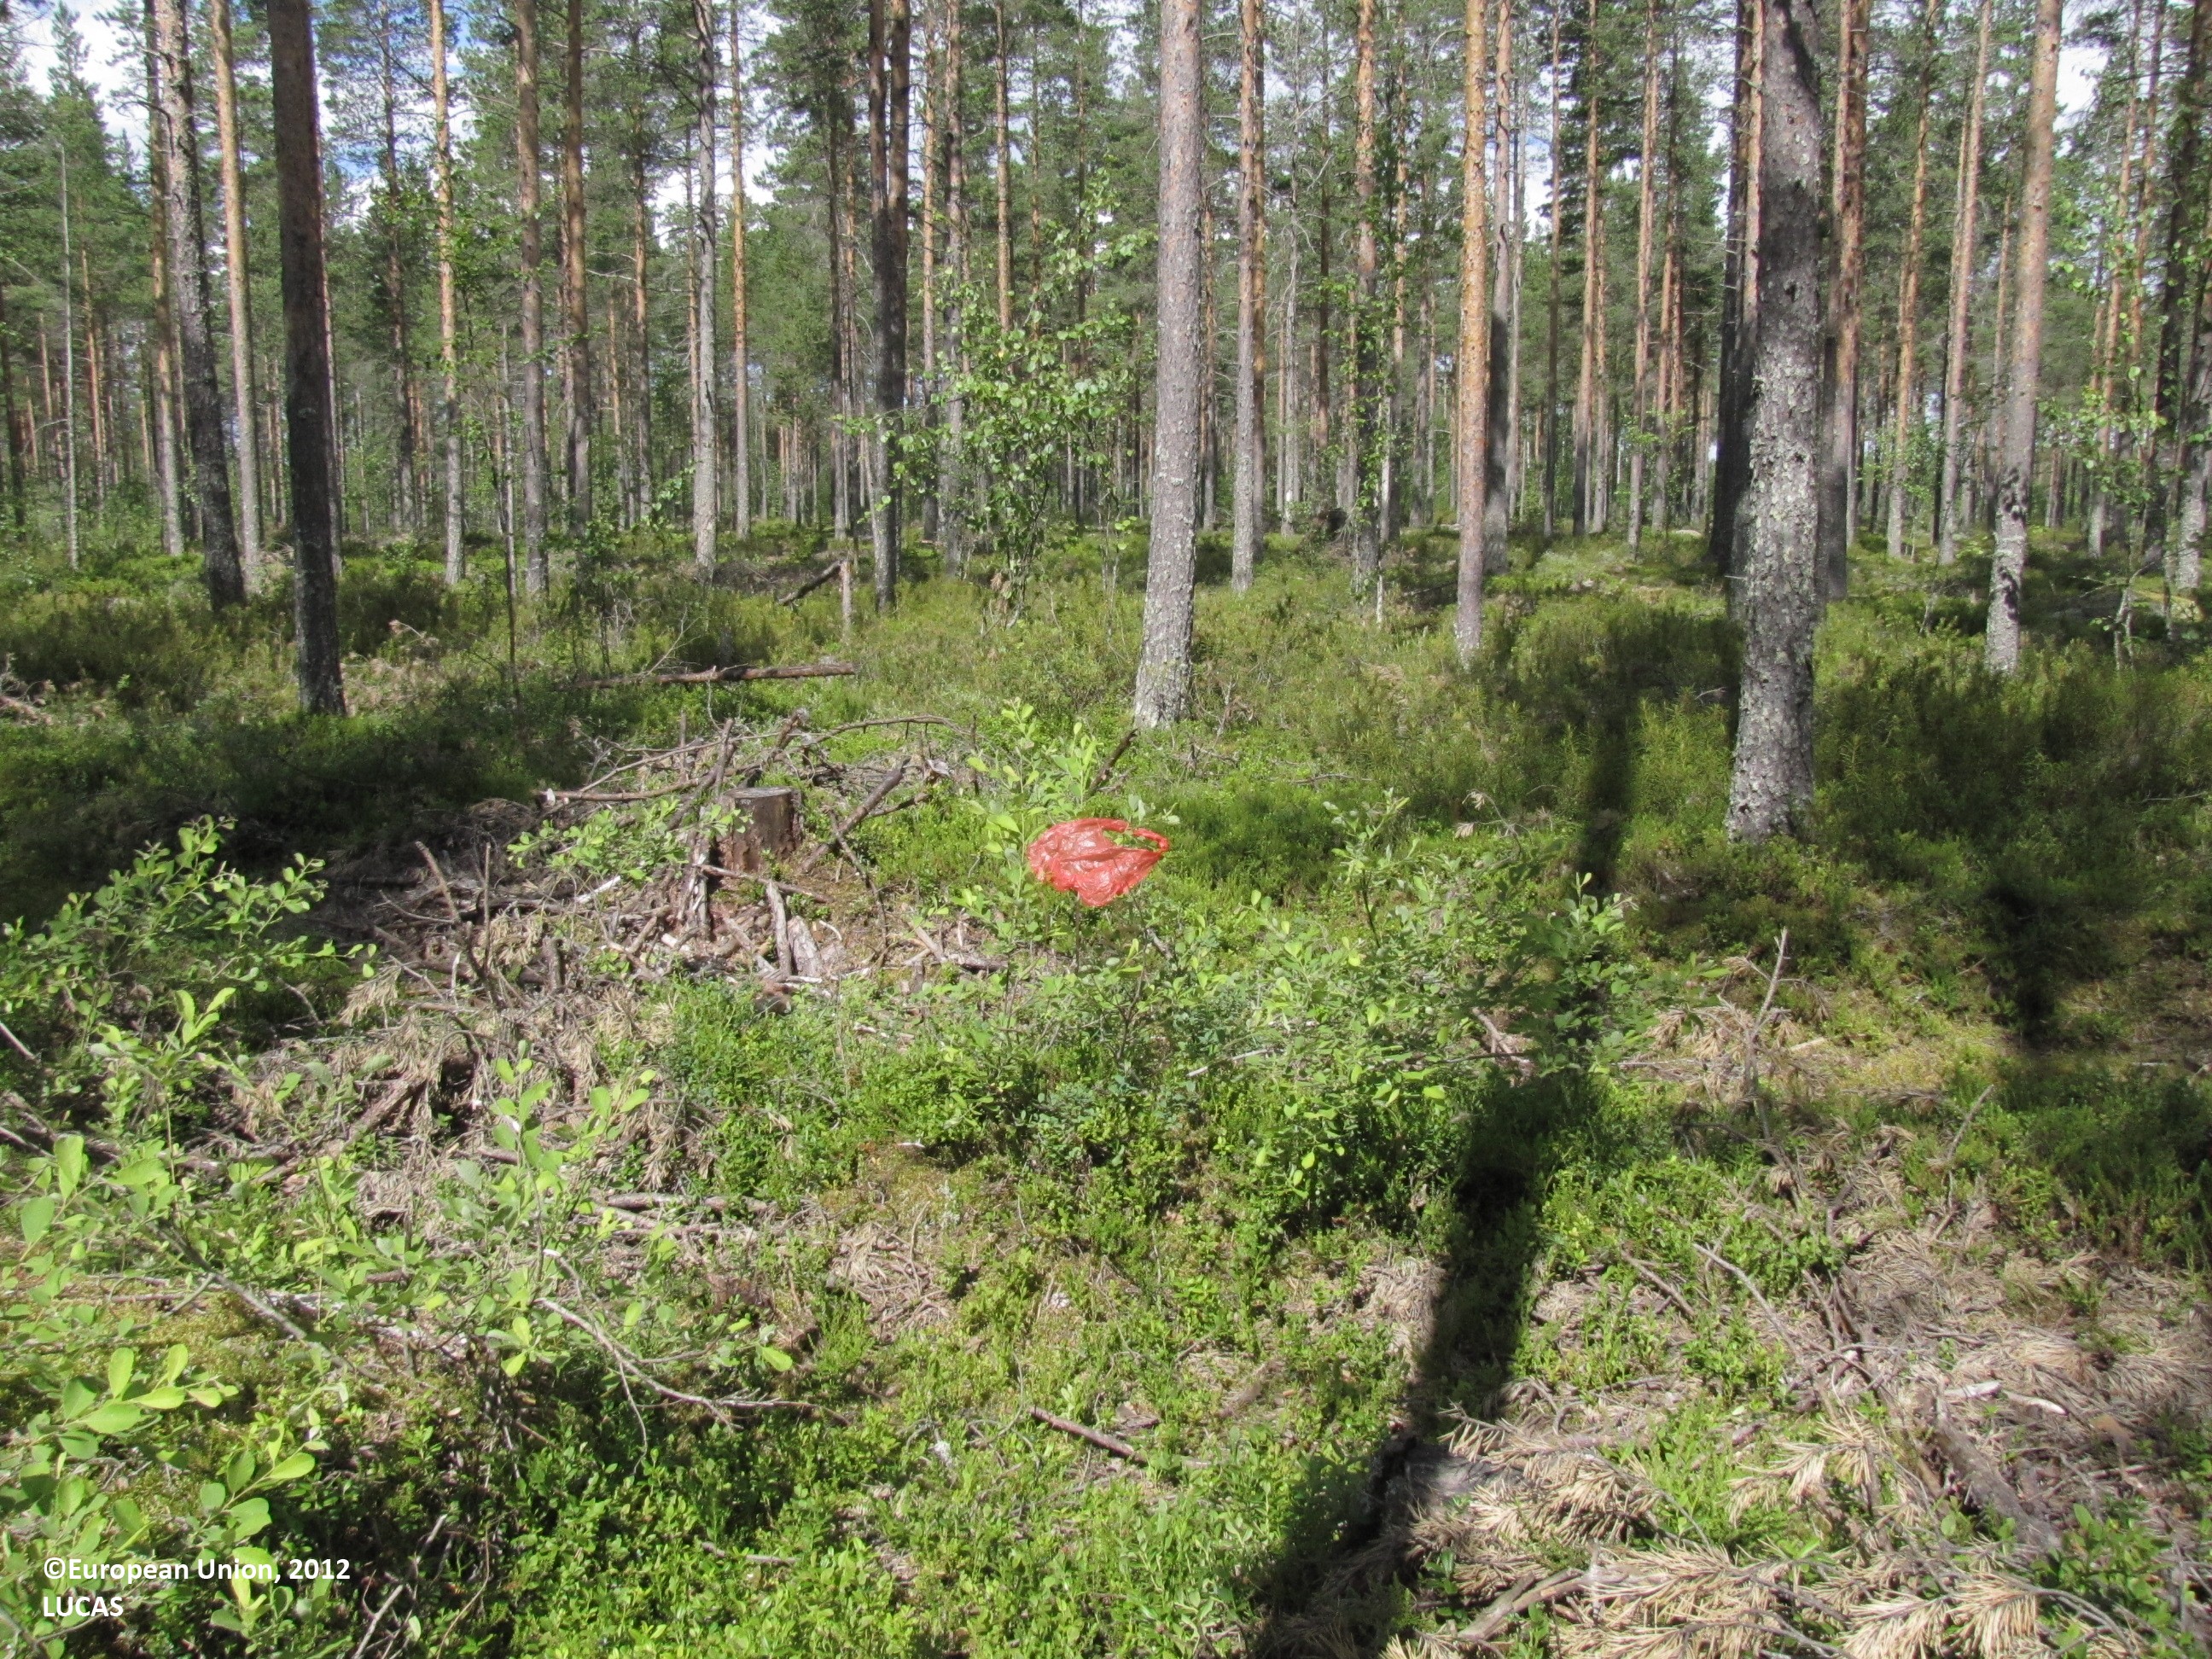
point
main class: Woodland
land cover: Pine dominated coniferous woodland
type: boreal forest
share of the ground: 50 - 75 %
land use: Forestry
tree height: > 5 m
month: July
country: FI
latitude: 62.6692
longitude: 23.2039
